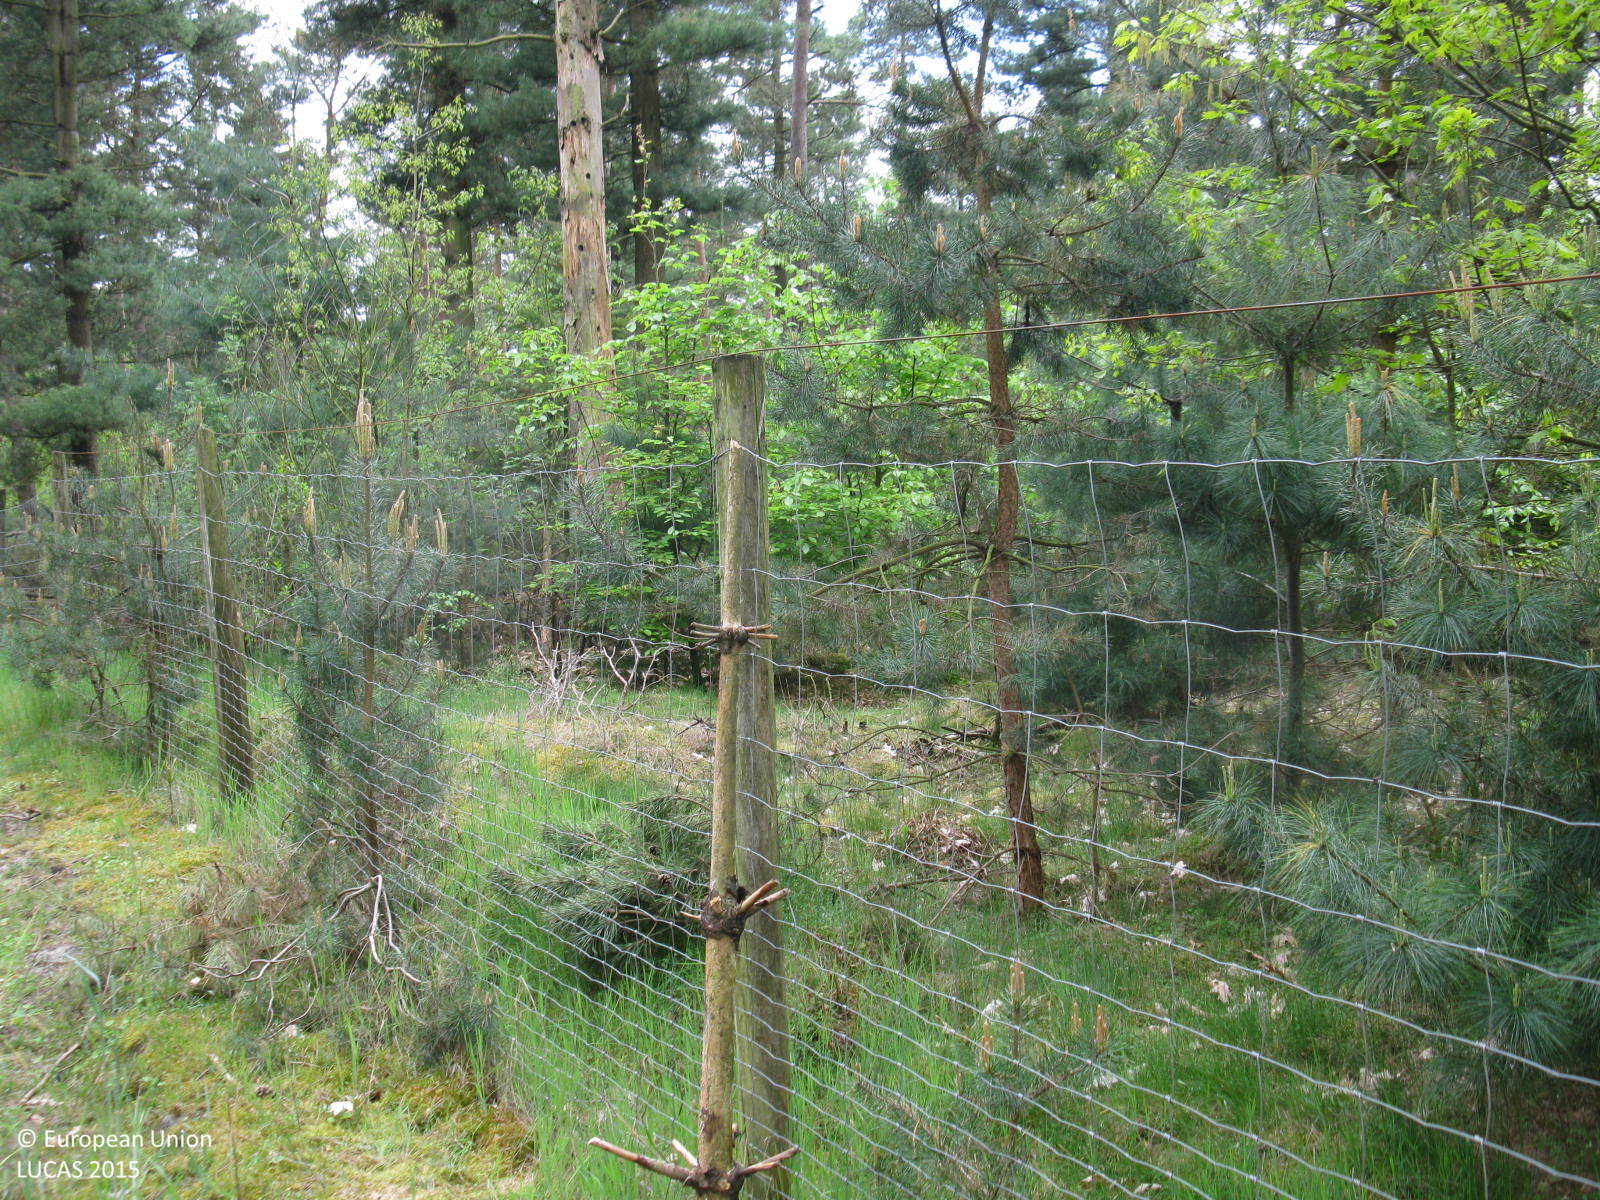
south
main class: Woodland
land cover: Pine dominated coniferous woodland
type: hemiboreal forest and nemoral coniferous forest and mixed broadleaved-coniferous forest
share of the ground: 50 - 75 %
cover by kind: coniferous forest trees 70 %, broadleaved forest trees 10 %, shrubs 10 %, herbaceous plants 10 %
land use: Forestry
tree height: > 5 m
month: May
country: DE
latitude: 52.8333
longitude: 7.3435
